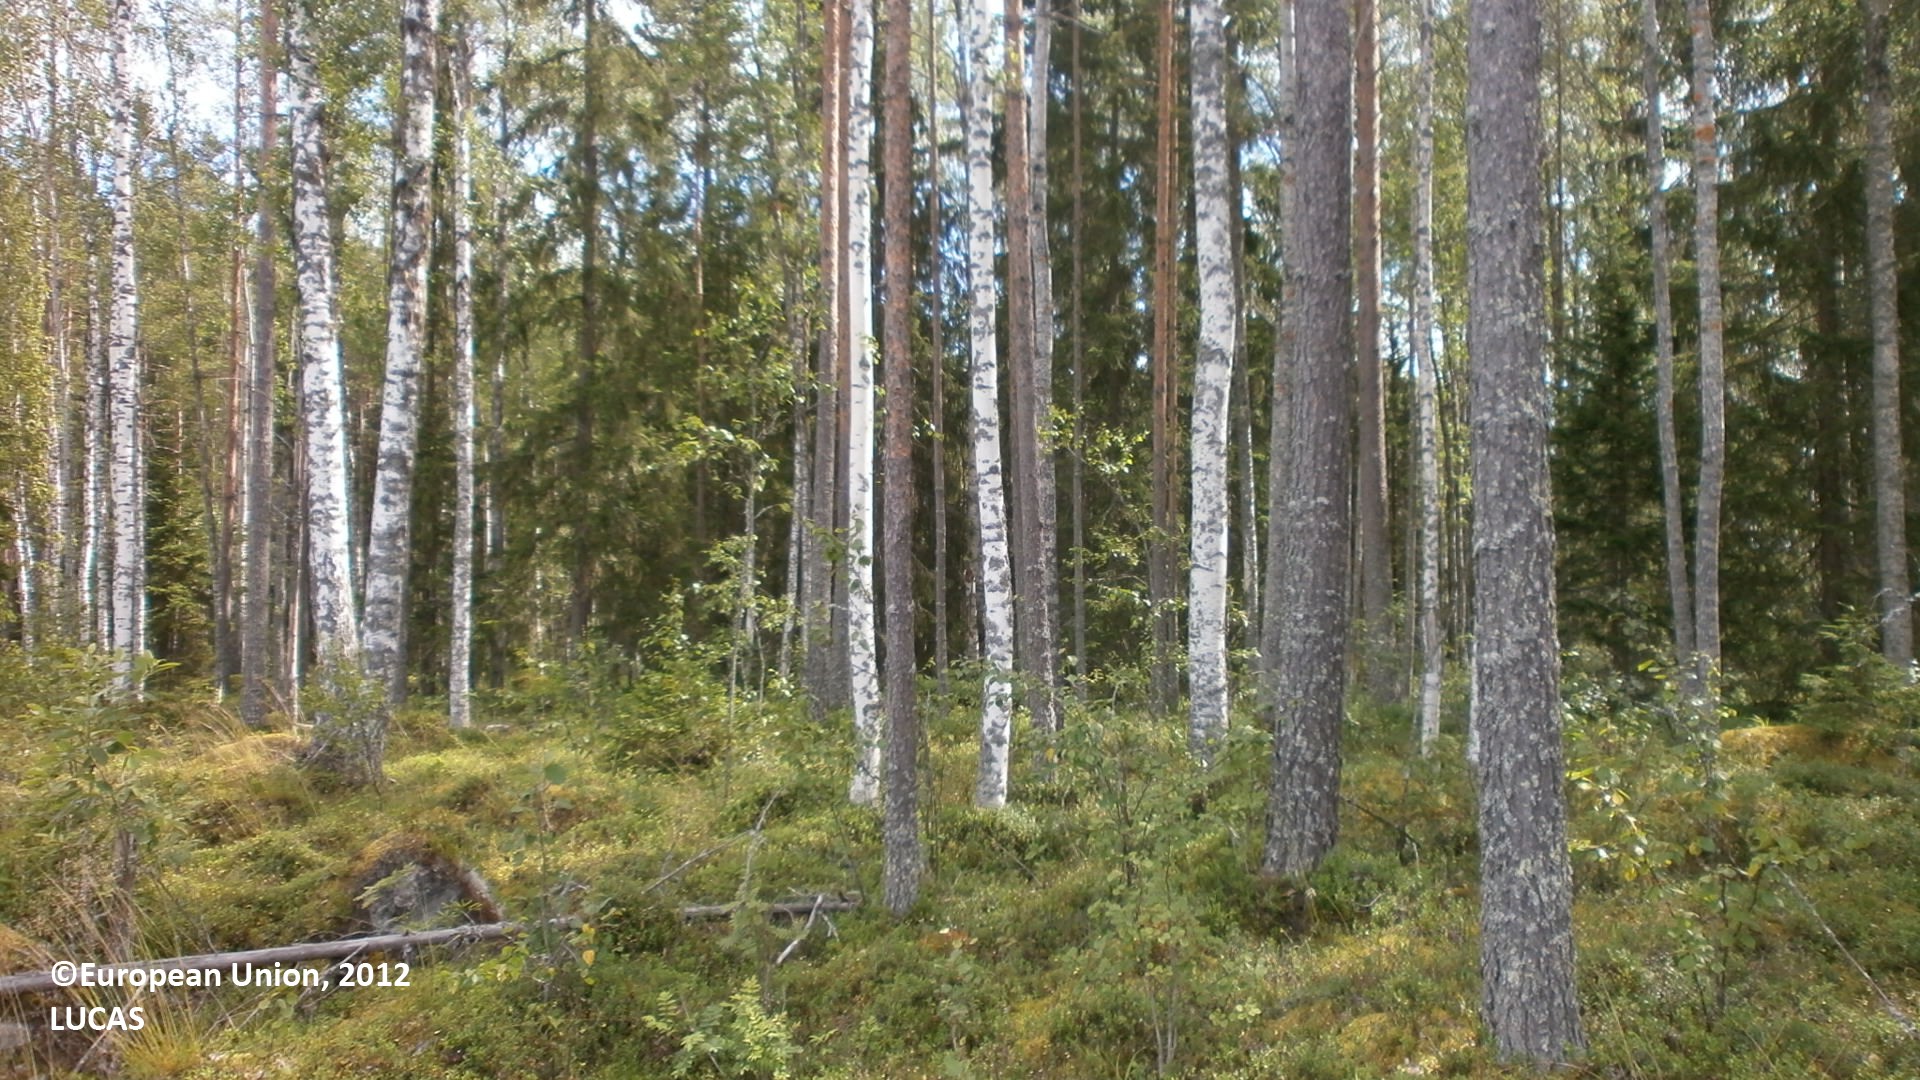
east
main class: Shrubland
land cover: Shrubland with sparse tree cover
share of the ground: > 75 %
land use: Forestry
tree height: < 5 m
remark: Clear cut
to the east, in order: Shrubland with sparse tree cover; Spruce dominated mixed woodland; Ditches and canals; Shruby margins; Other bare soil; Spontaneously vegetated surfaces; Ditches and canals; Spruce dominated mixed woodland; Spruce dominated coniferous woodland; Tracks
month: July
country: FI
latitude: 64.0443
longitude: 24.2611
